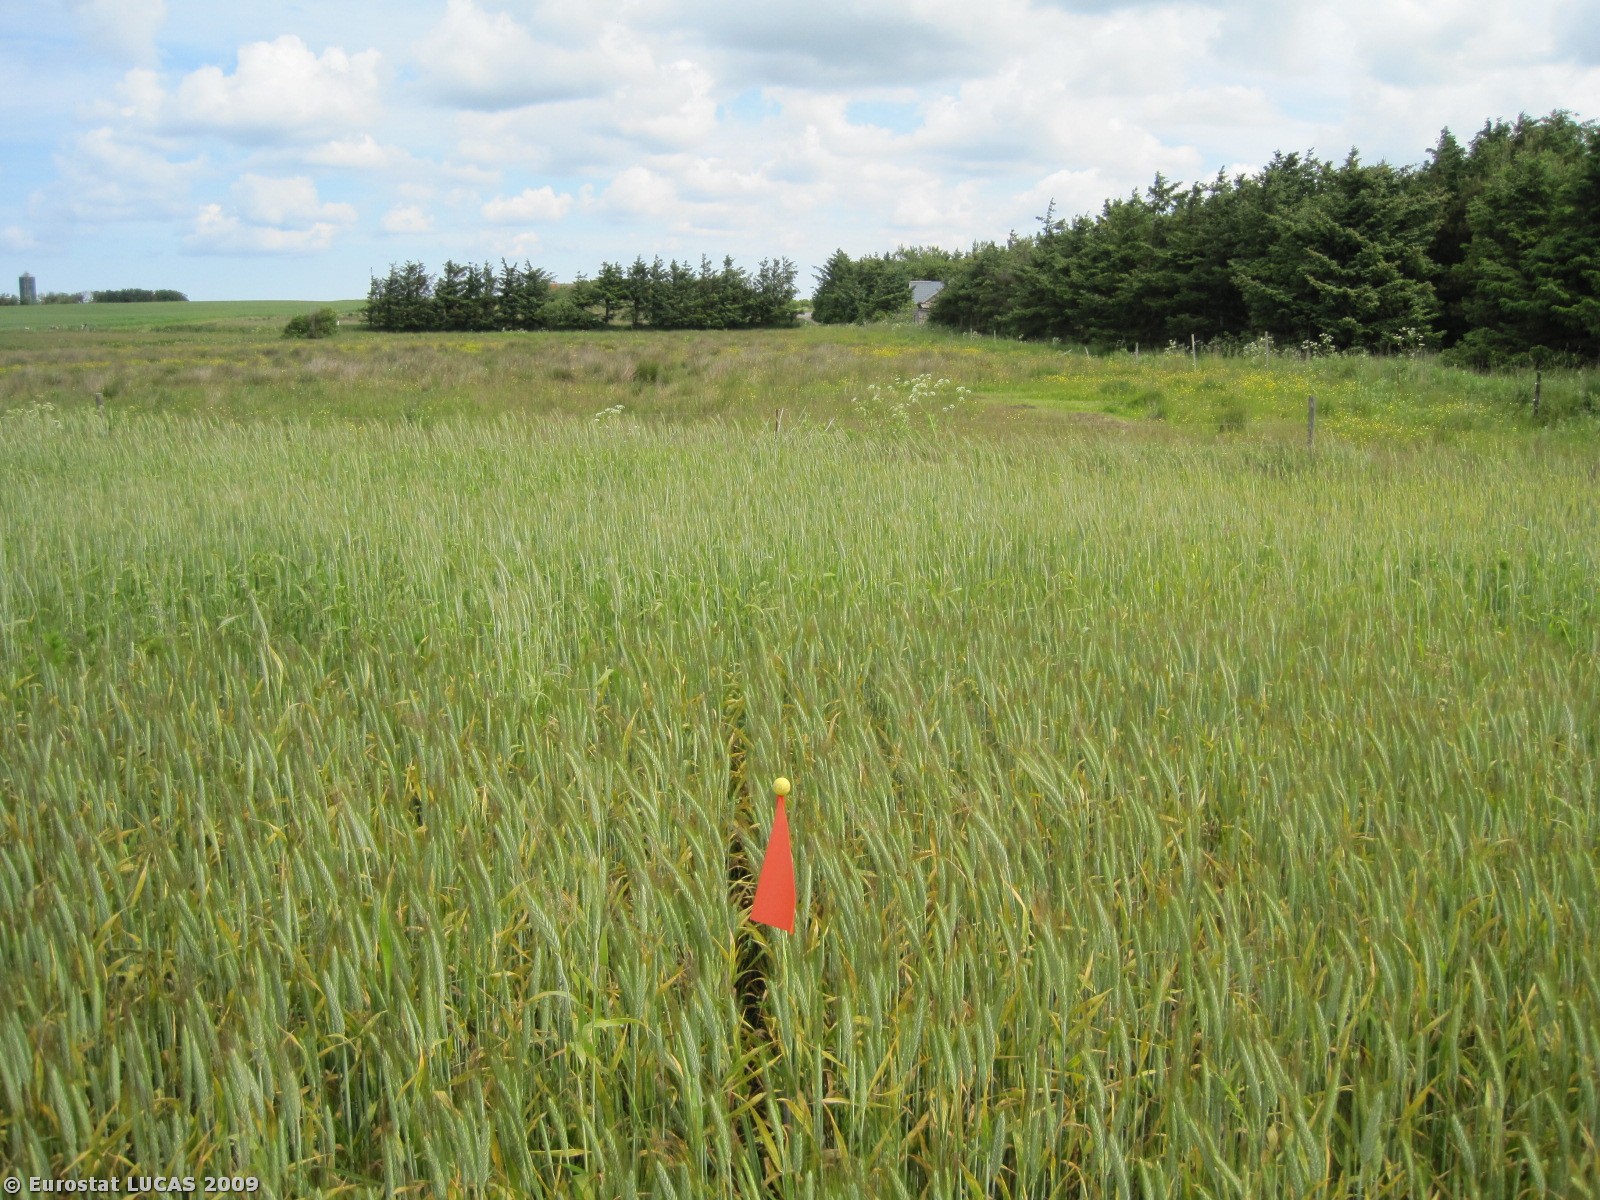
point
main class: Cropland
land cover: Barley
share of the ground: > 75 %
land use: Agriculture (excluding fallow land and kitchen gardens)
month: June
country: DK
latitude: 57.3740
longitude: 9.7510
